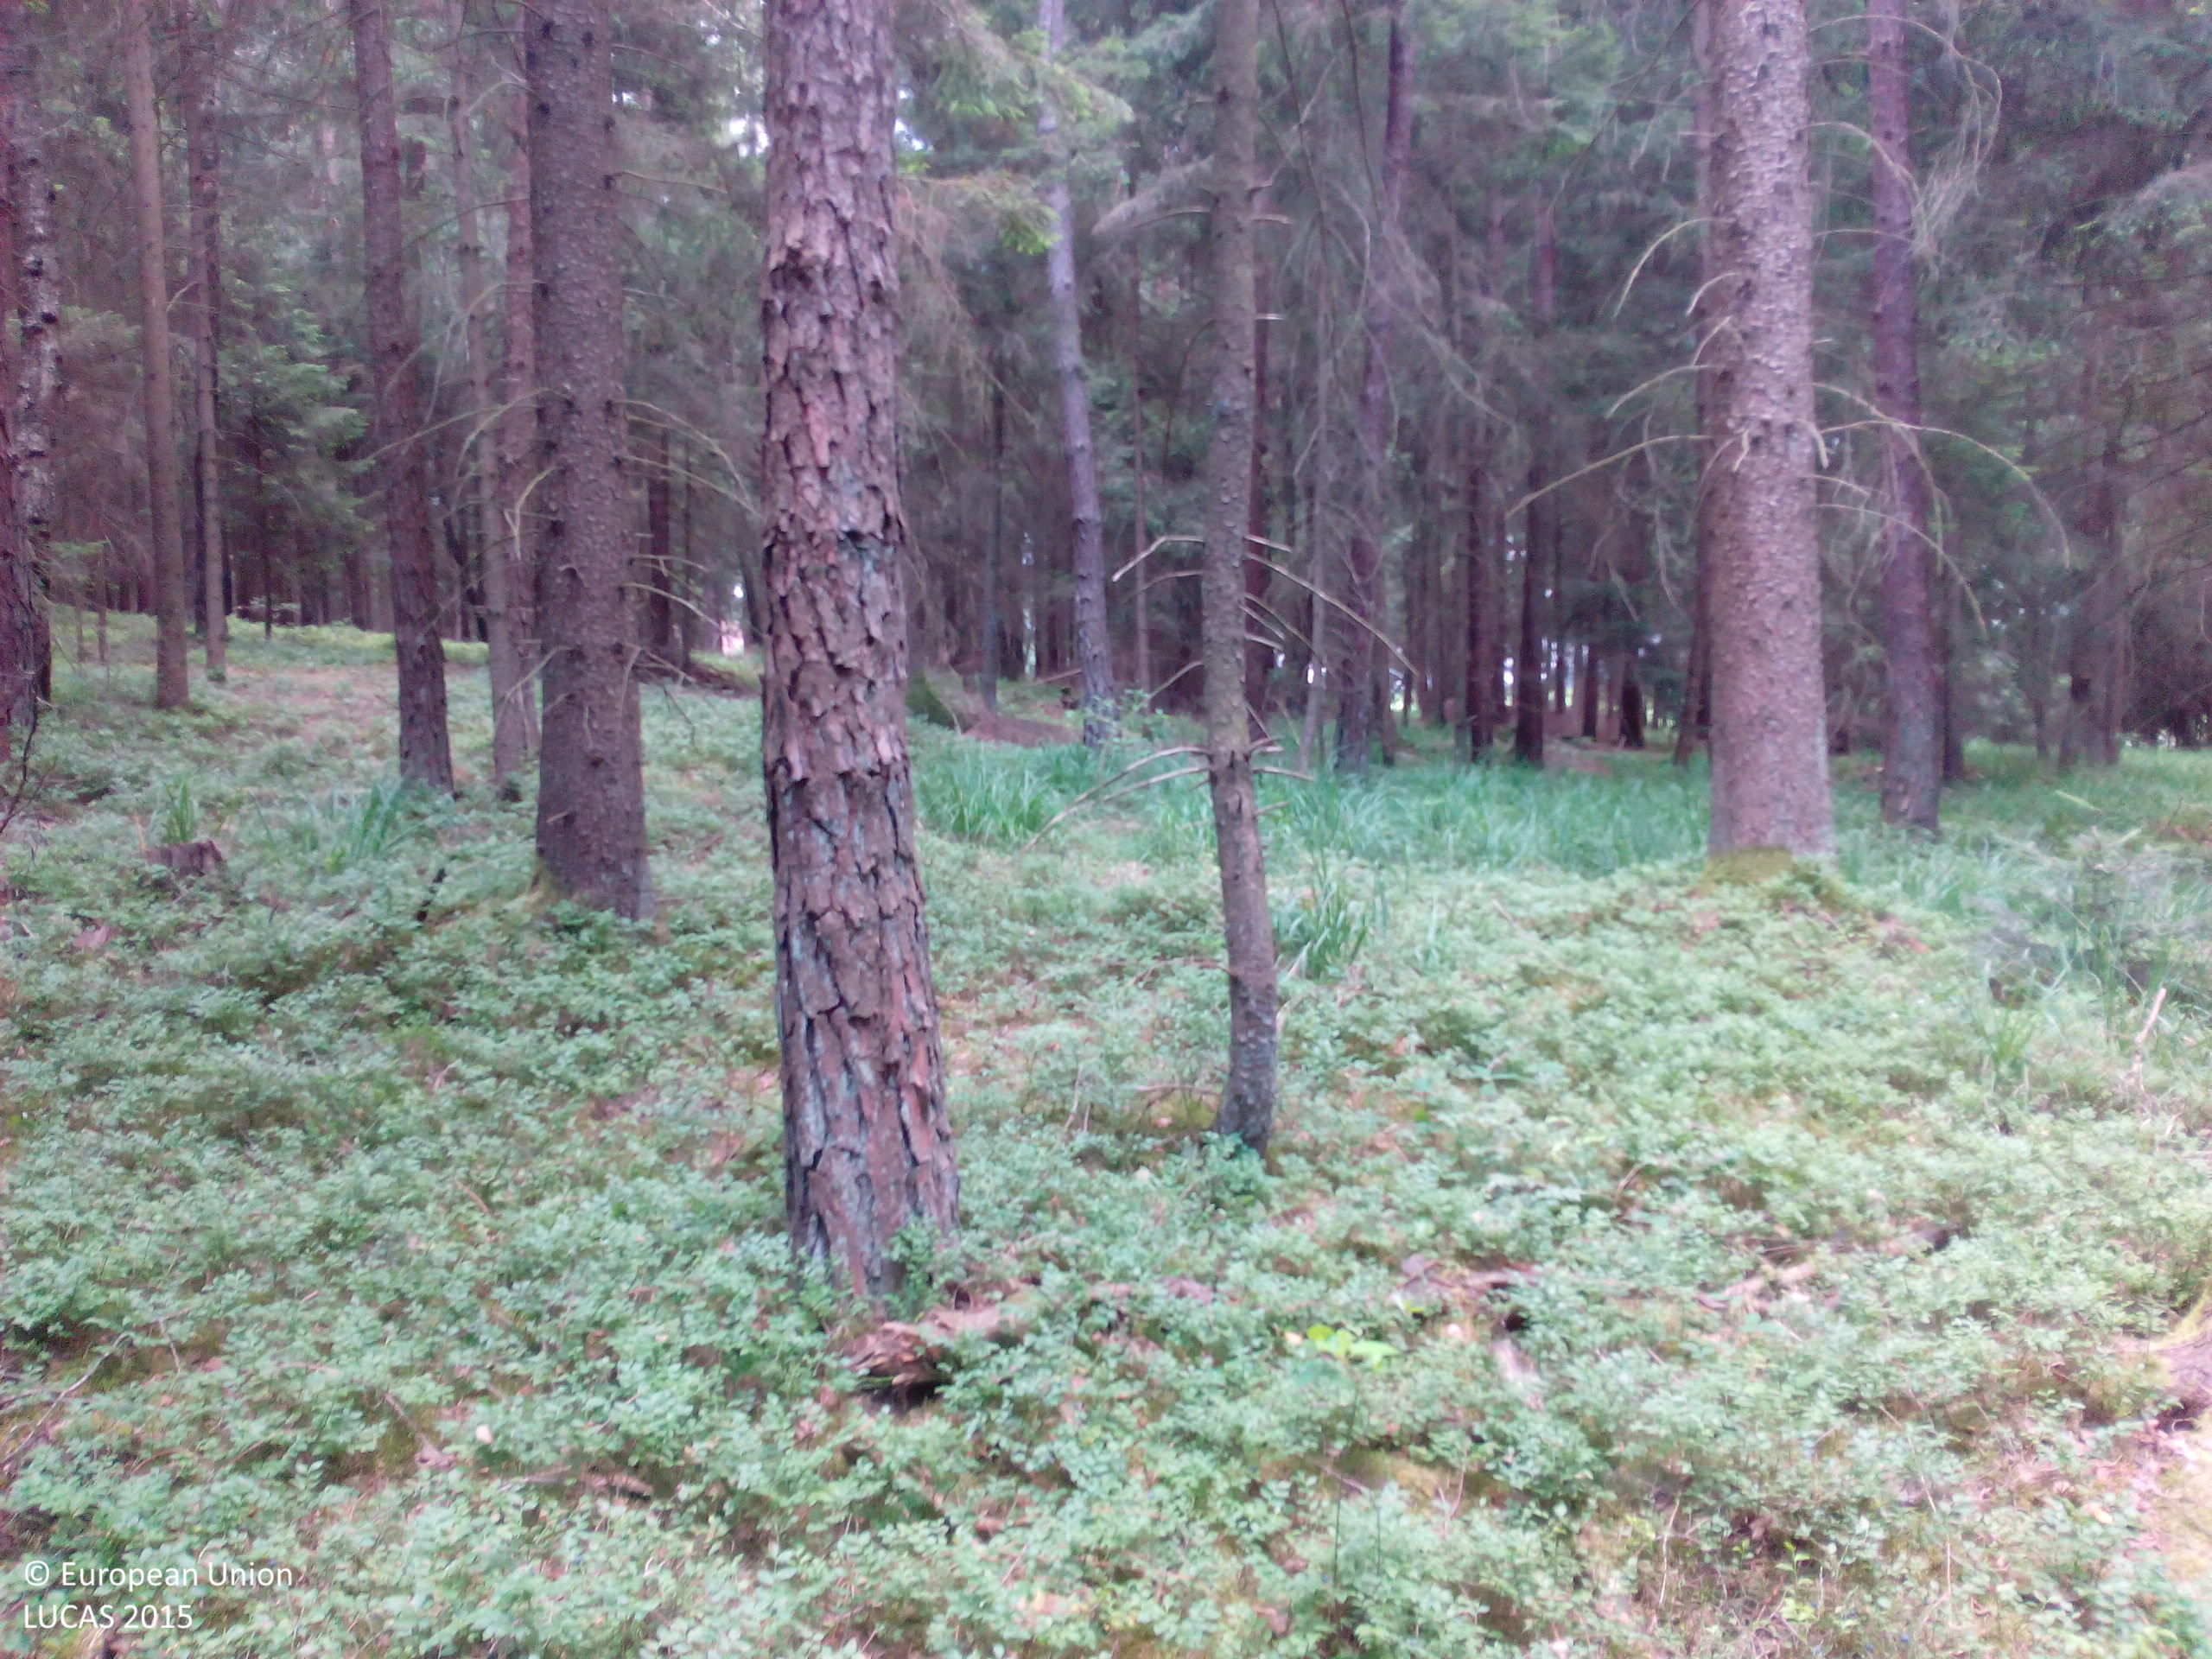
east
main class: Woodland
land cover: Other coniferous woodland
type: hemiboreal forest and nemoral coniferous forest and mixed broadleaved-coniferous forest
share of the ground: 50 - 75 %
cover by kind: coniferous forest trees 55 %, shrubs 20 %, herbaceous plants 10 %, lichens and mosses 10 %, broadleaved forest trees 5 %
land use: Forestry
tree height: > 5 m
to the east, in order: Other coniferous woodland; Spruce dominated coniferous woodland; Tracks; Spruce dominated mixed woodland; Common wheat
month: June
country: DE
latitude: 48.5452
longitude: 12.9116
